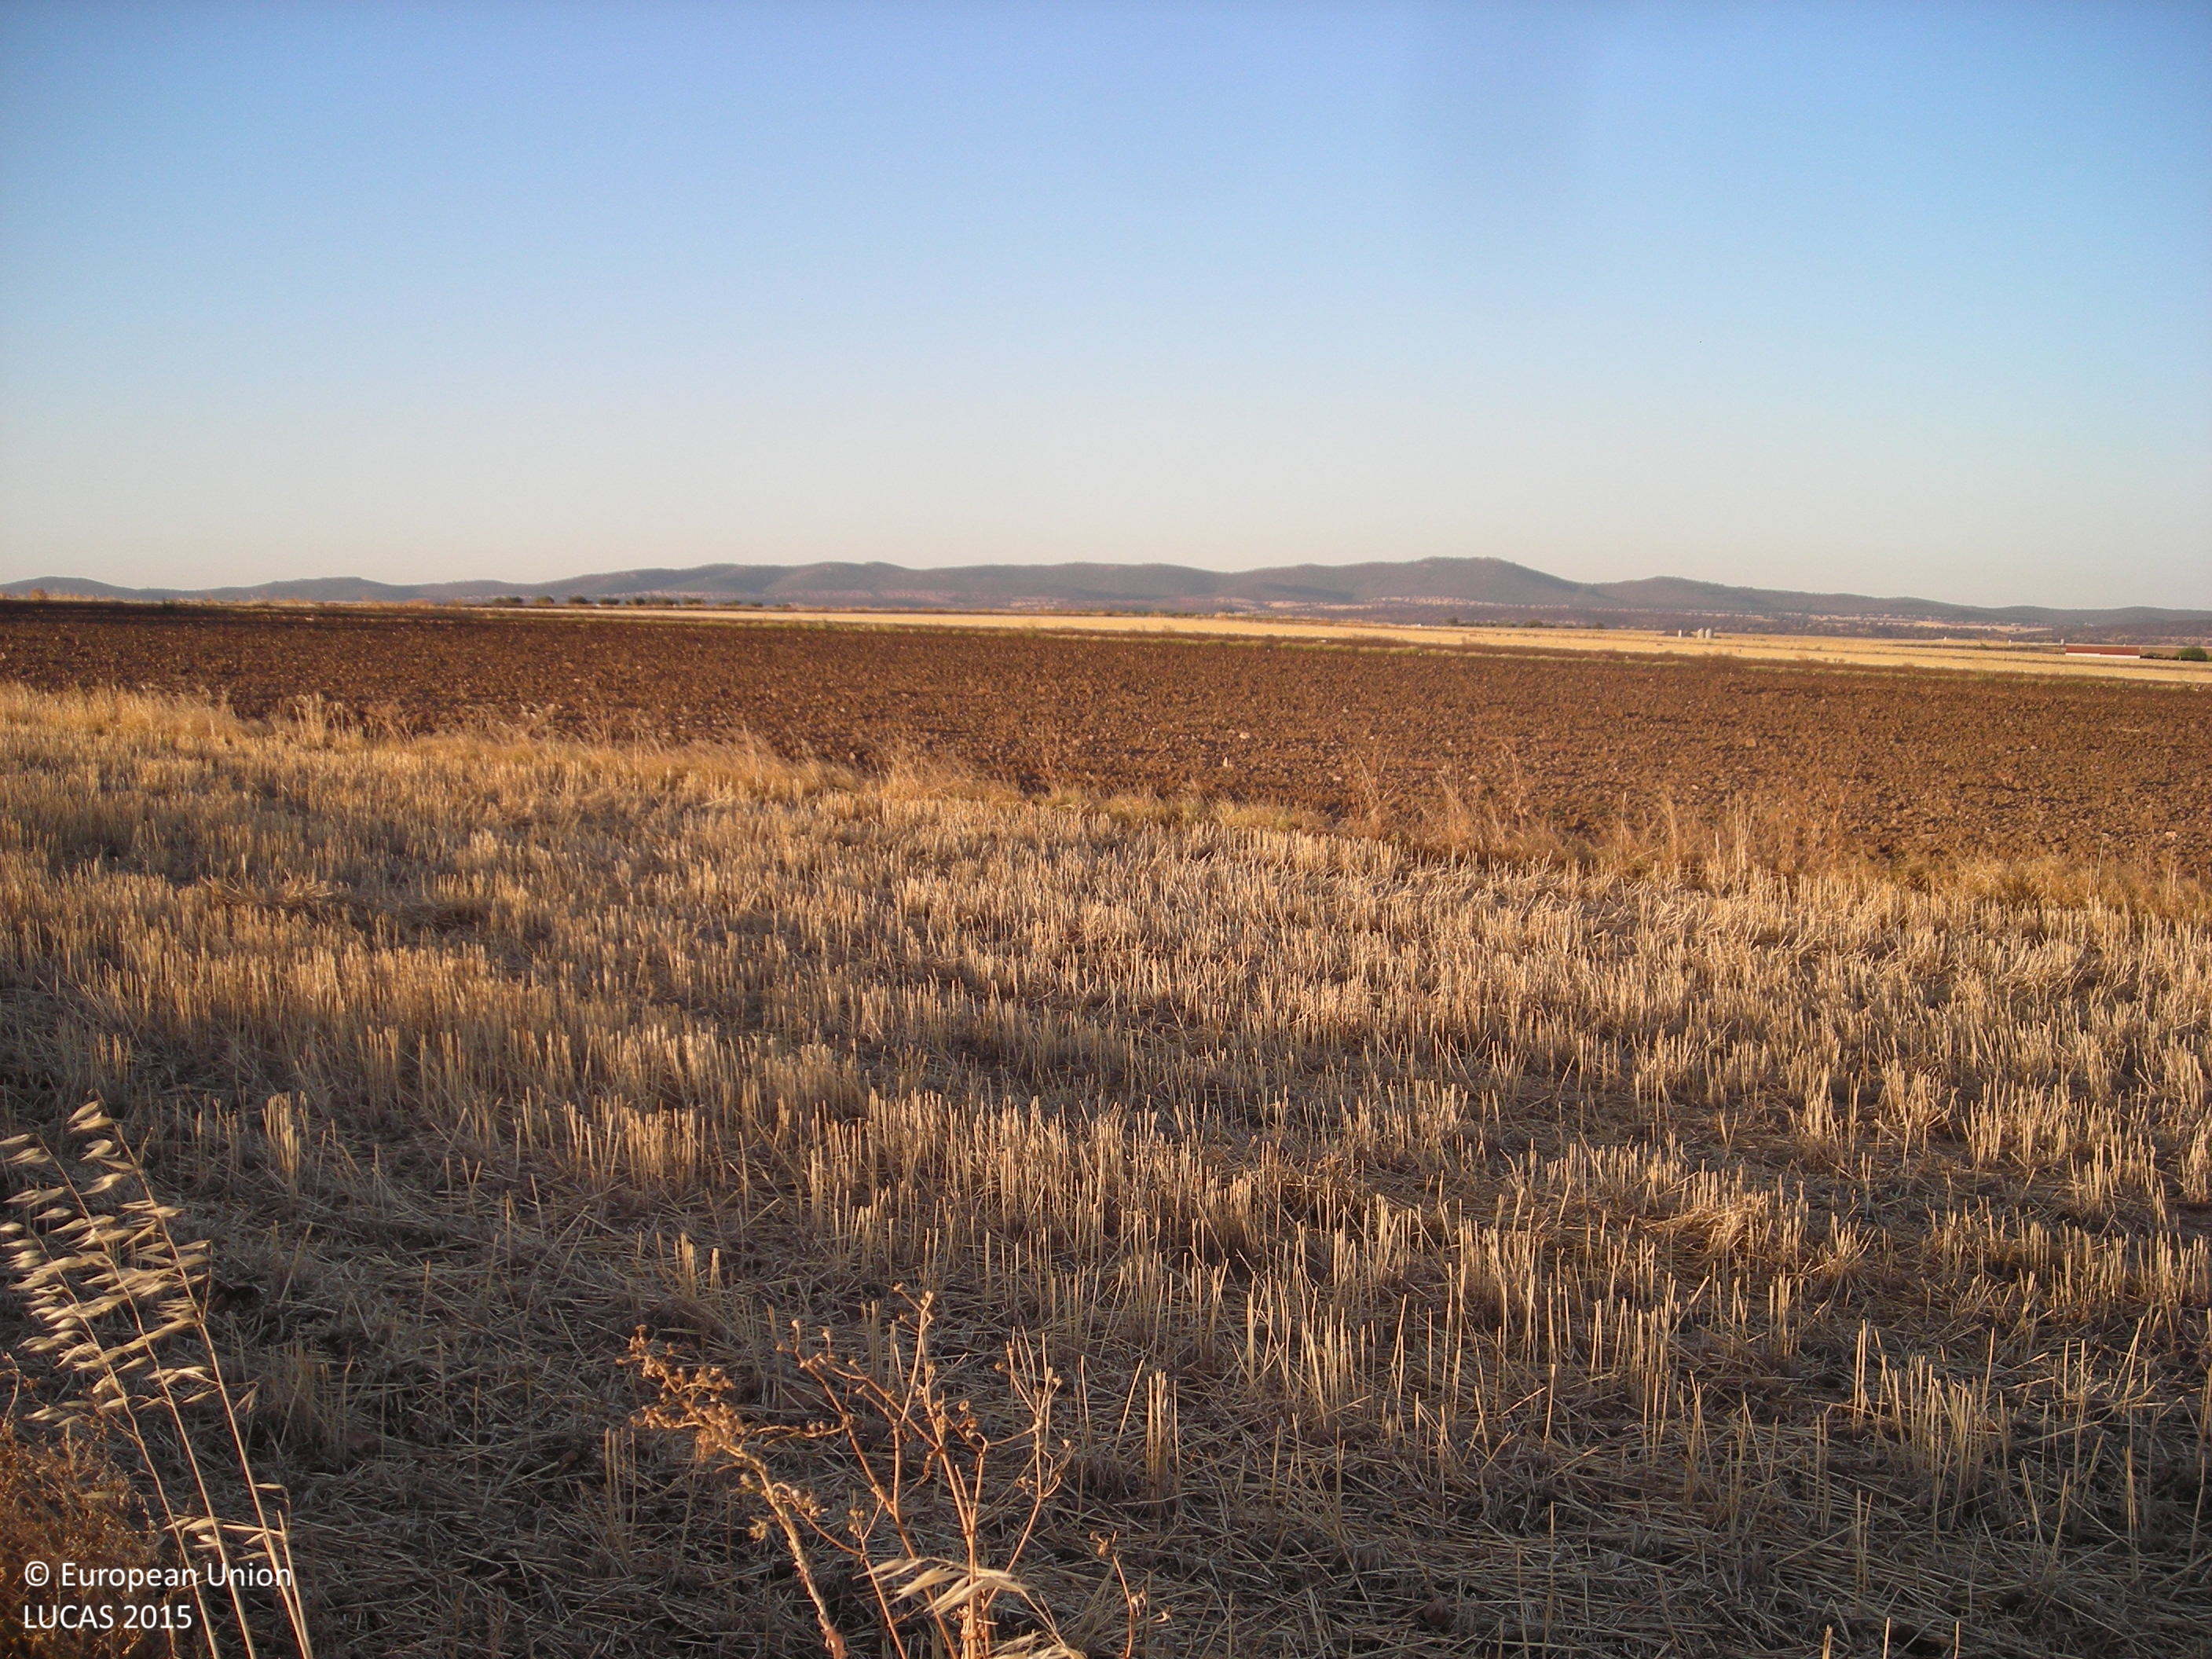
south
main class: Cropland
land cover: Common wheat
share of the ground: > 75 %
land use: Agriculture (excluding fallow land and kitchen gardens)
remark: Harvested field
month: July
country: ES
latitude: 38.9026
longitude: -5.8103
